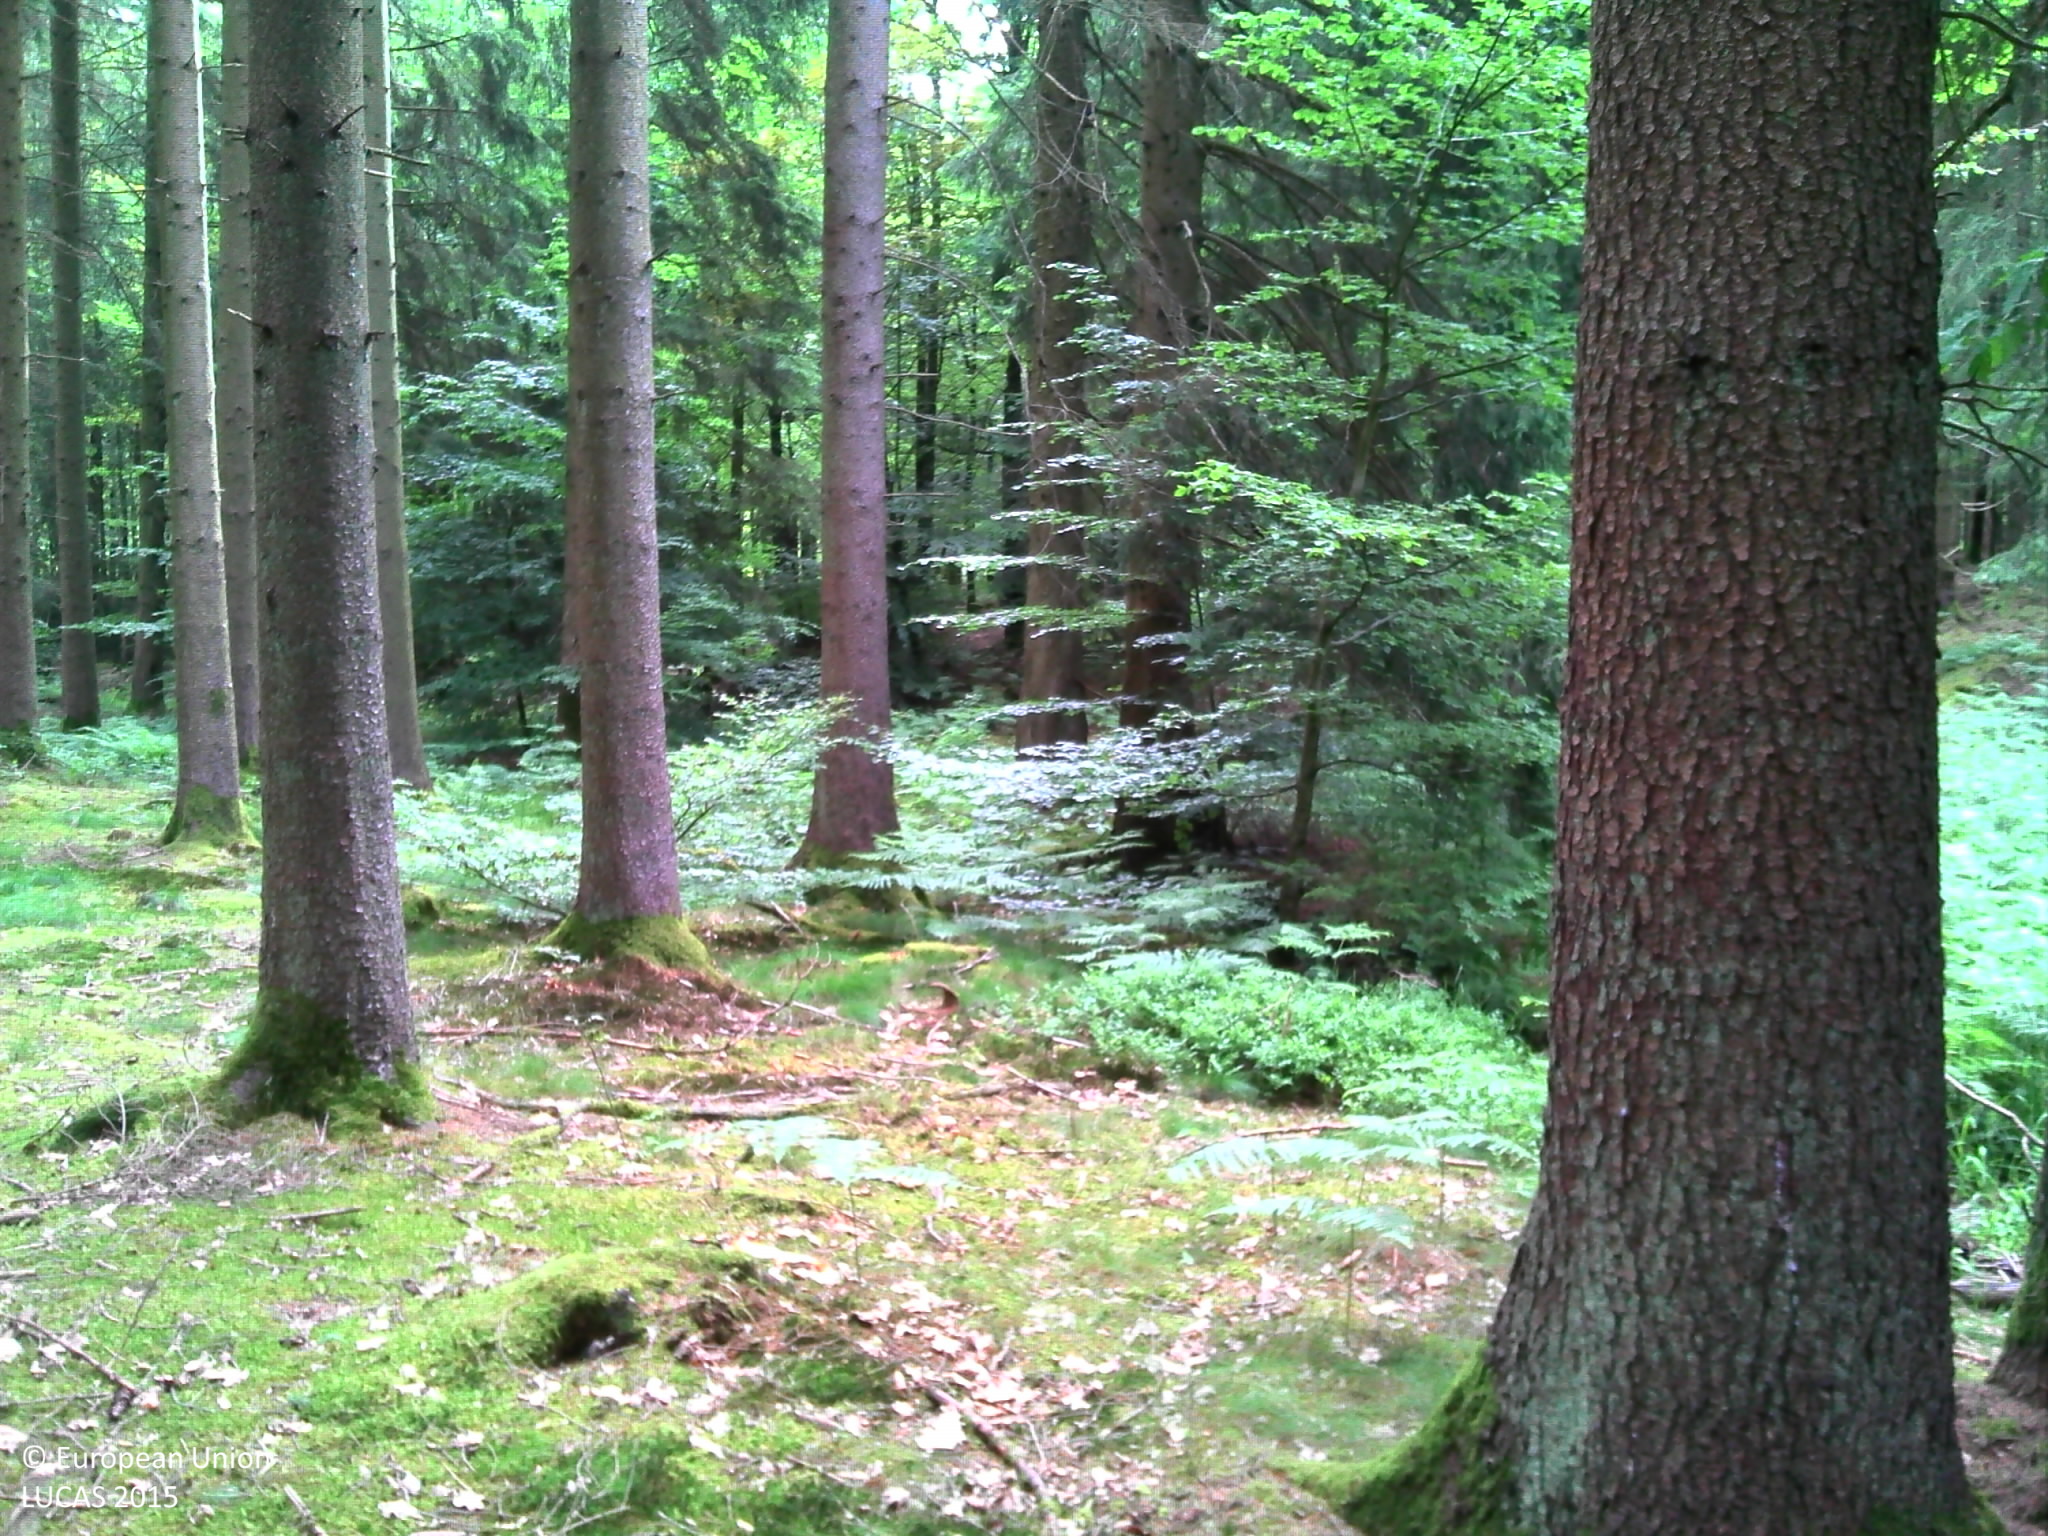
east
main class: Woodland
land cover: Spruce dominated coniferous woodland
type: alpine coniferous forest
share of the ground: > 75 %
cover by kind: coniferous forest trees 80 %, herbaceous plants 10 %, lichens and mosses 10 %
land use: Forestry
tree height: > 5 m
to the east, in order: Spruce dominated coniferous woodland; Rivers and streams; Spruce dominated coniferous woodland; Broadleaved woodland; Rivers and streams; Broadleaved woodland; Tracks; Broadleaved woodland
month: June
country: BE
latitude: 49.9254
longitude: 5.3037
